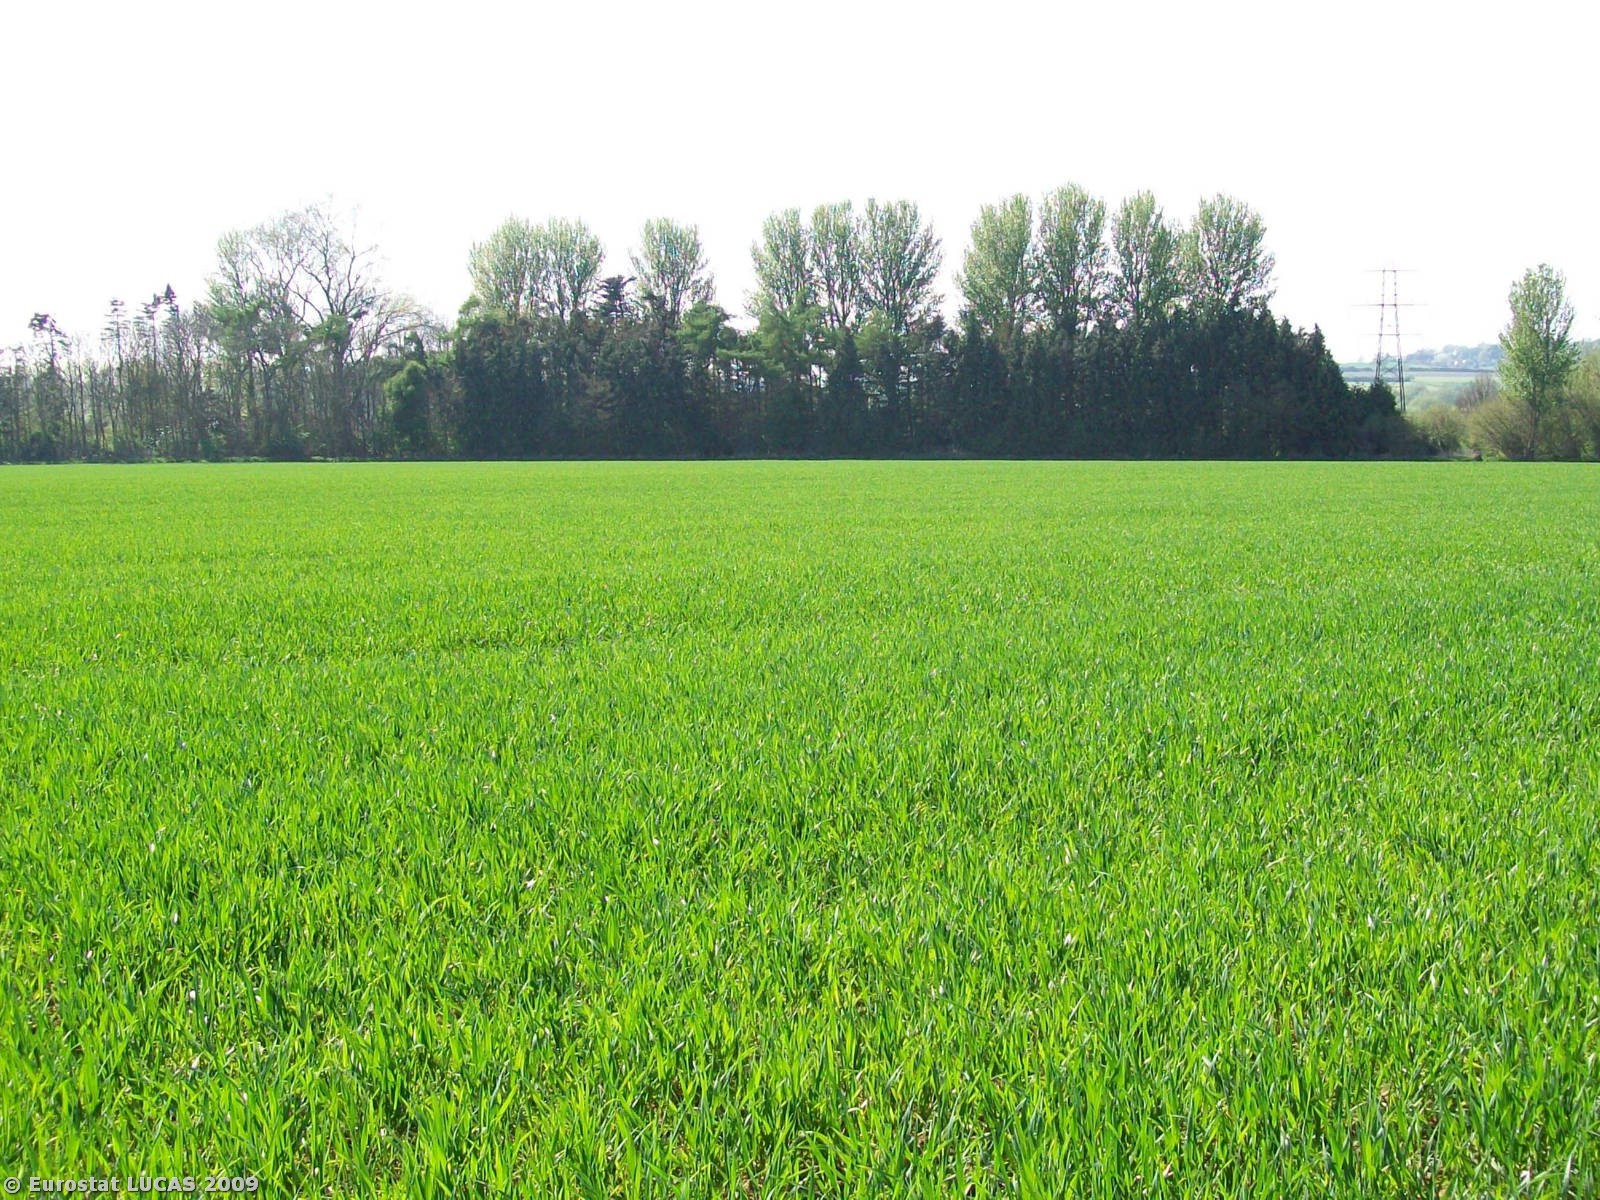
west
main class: Cropland
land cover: Common wheat
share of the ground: > 75 %
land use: Agriculture (excluding fallow land and kitchen gardens)
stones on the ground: 10 - 25 %
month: April
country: GB
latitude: 51.7083
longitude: -1.1169
